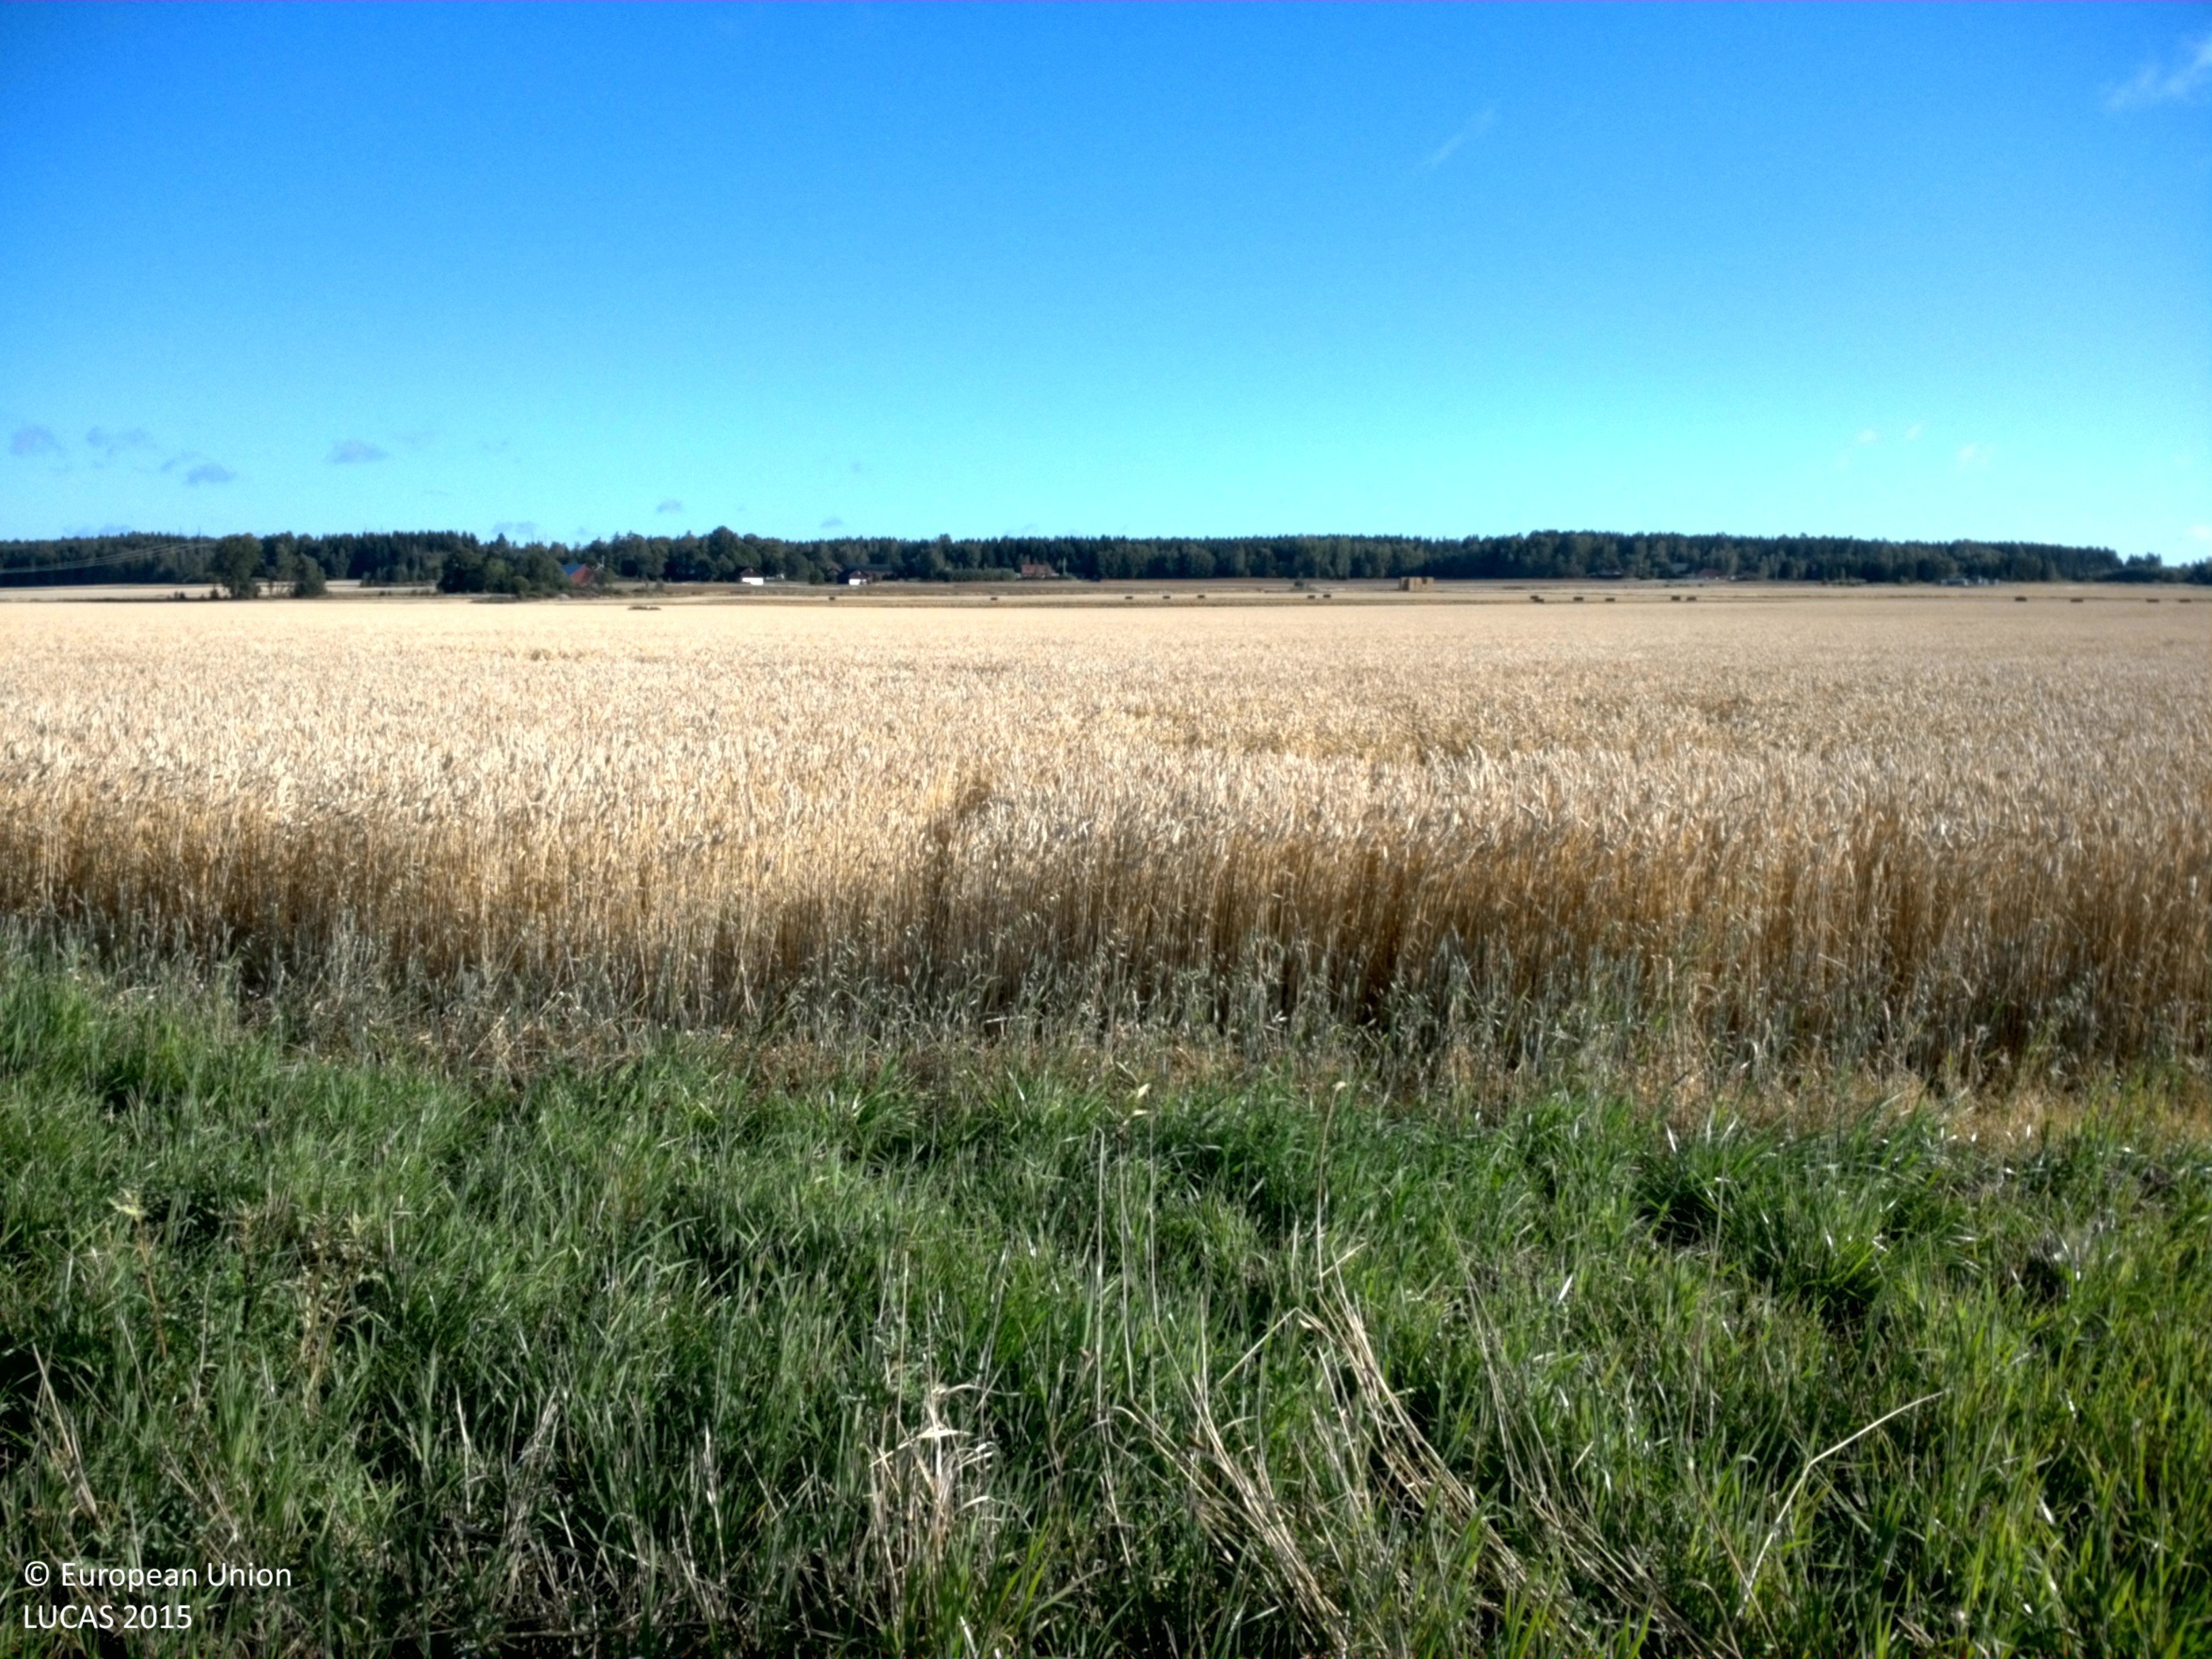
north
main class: Grassland
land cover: Grassland without tree/shrub cover
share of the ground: > 75 %
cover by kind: herbaceous plants 100 %
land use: Agriculture (excluding fallow land and kitchen gardens)
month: August
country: SE
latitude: 59.6881
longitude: 17.2233
